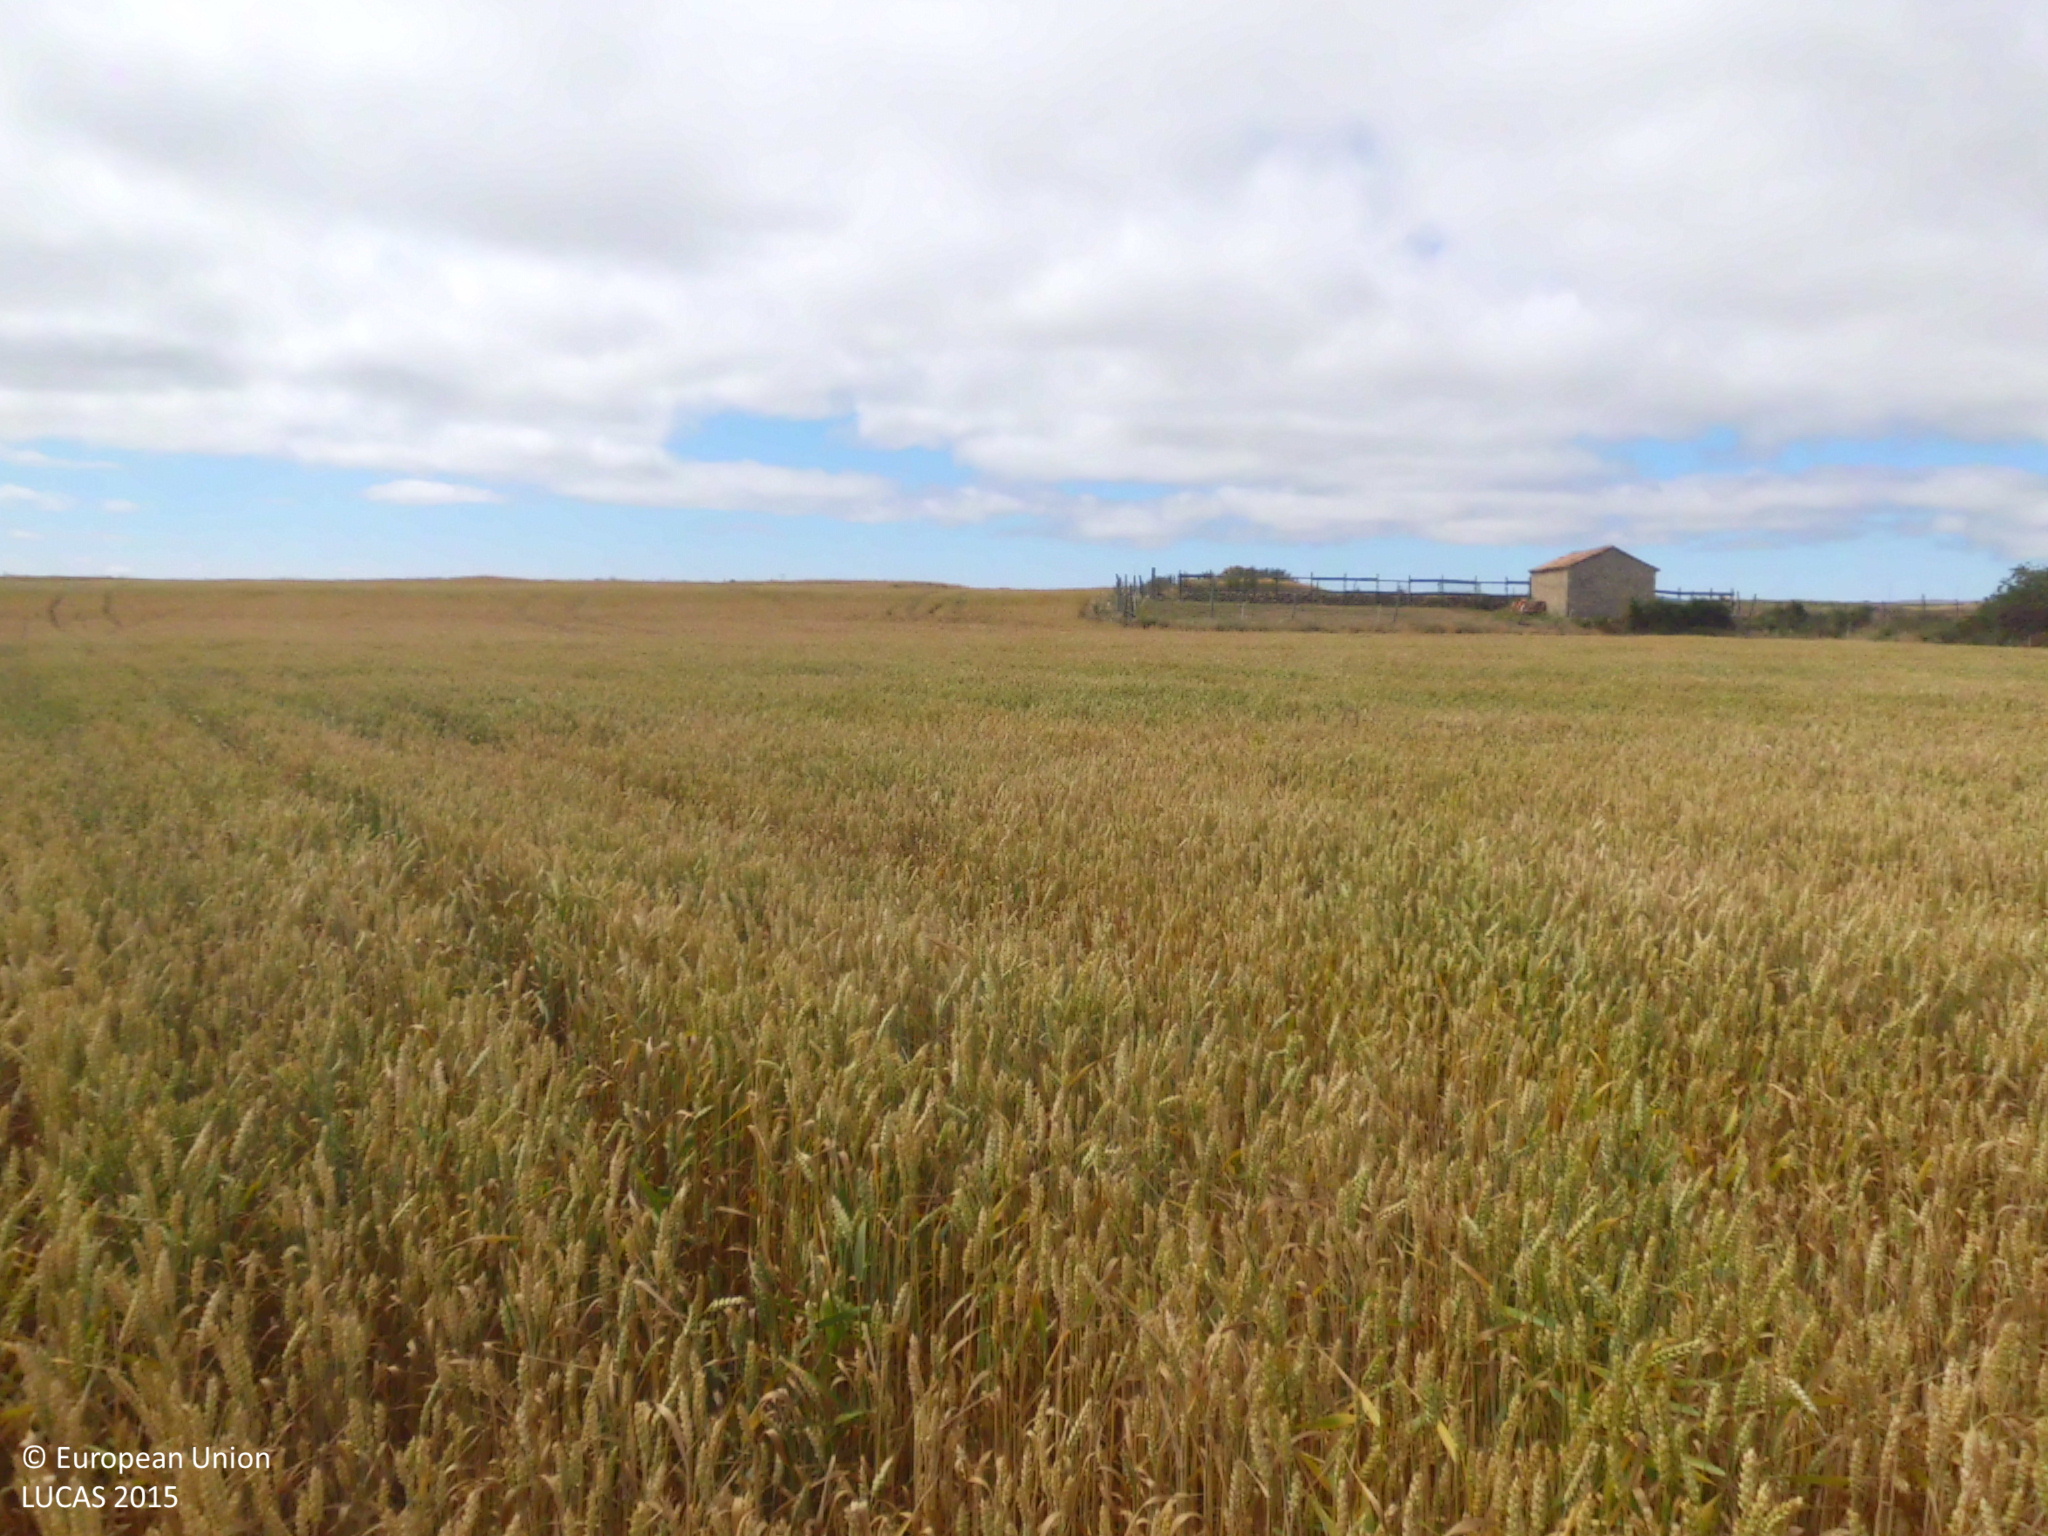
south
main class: Cropland
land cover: Common wheat
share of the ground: > 75 %
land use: Agriculture (excluding fallow land and kitchen gardens)
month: July
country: ES
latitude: 42.7443
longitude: -4.0830
